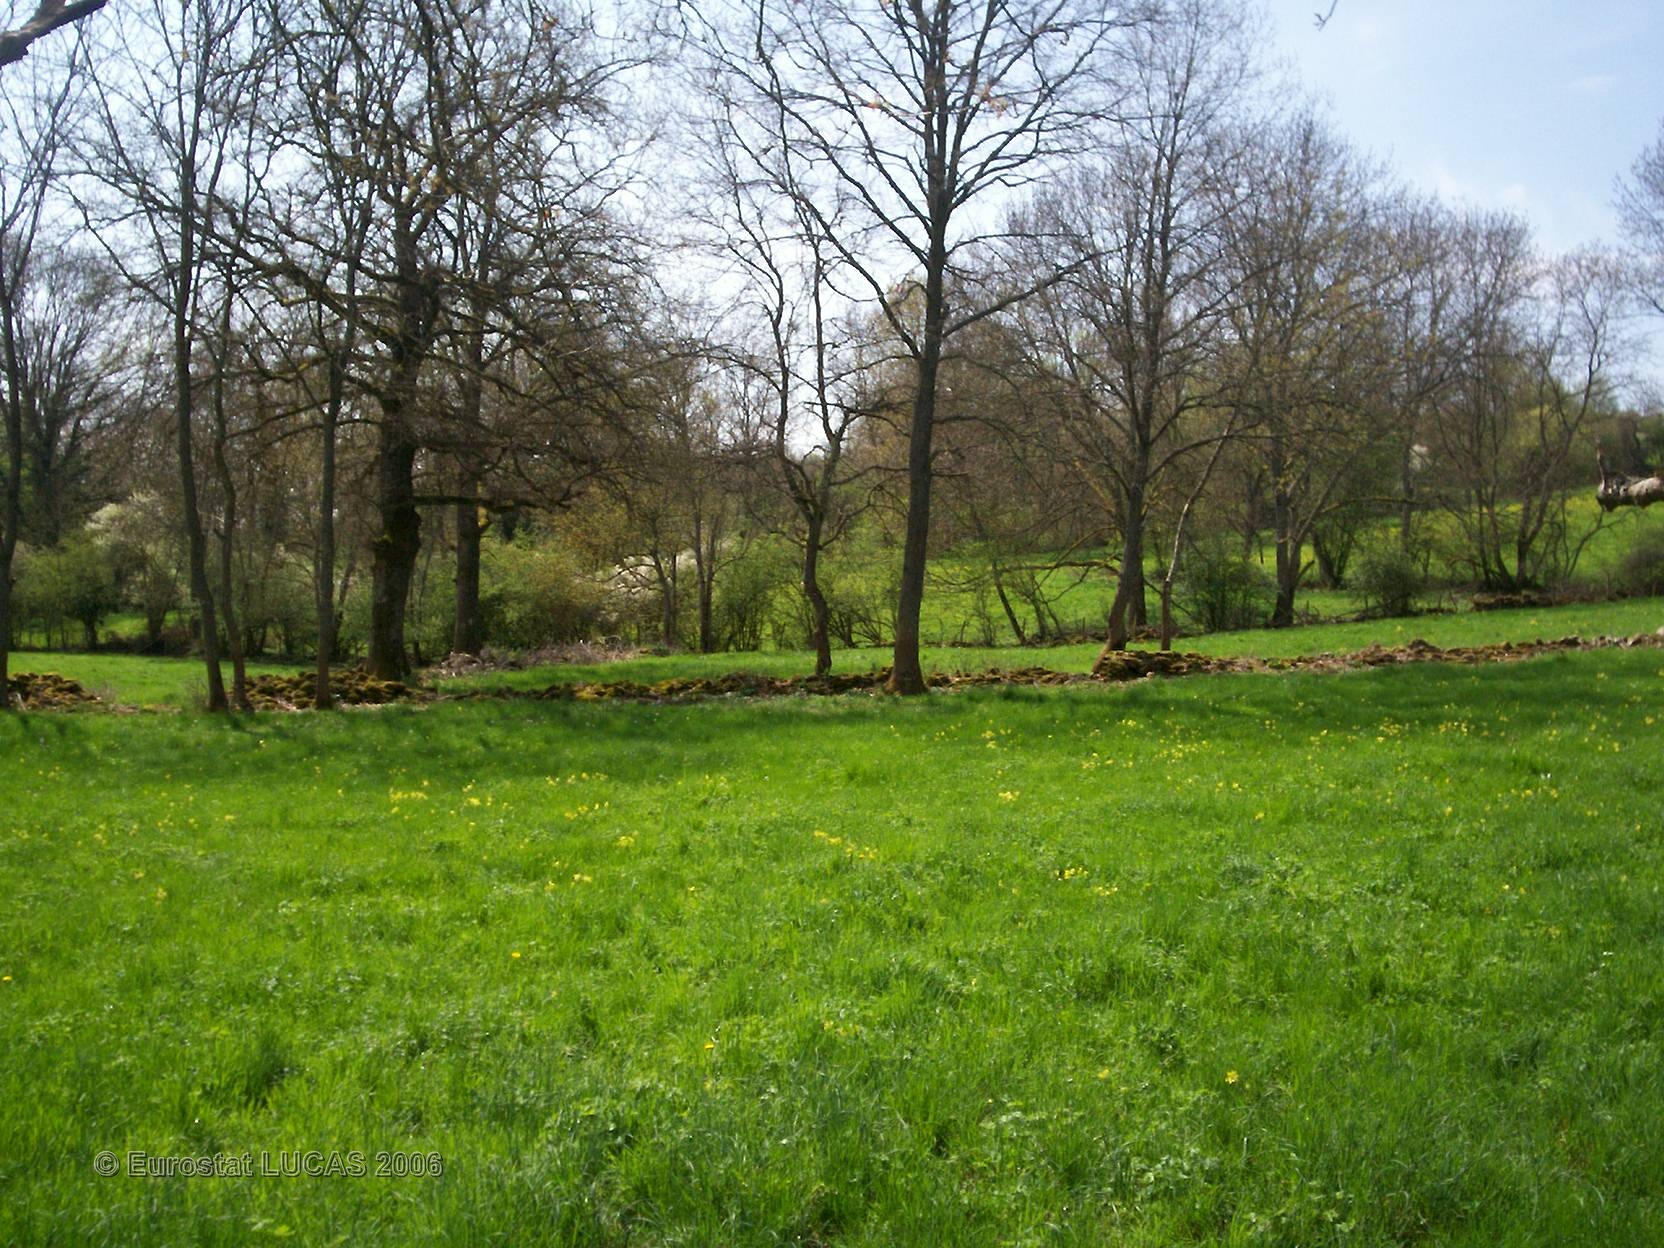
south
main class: Grassland
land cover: Grassland with sparse tree/shrub cover
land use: Agriculture (excluding fallow land and kitchen gardens)
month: April
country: FR
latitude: 46.9381
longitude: 4.6279
